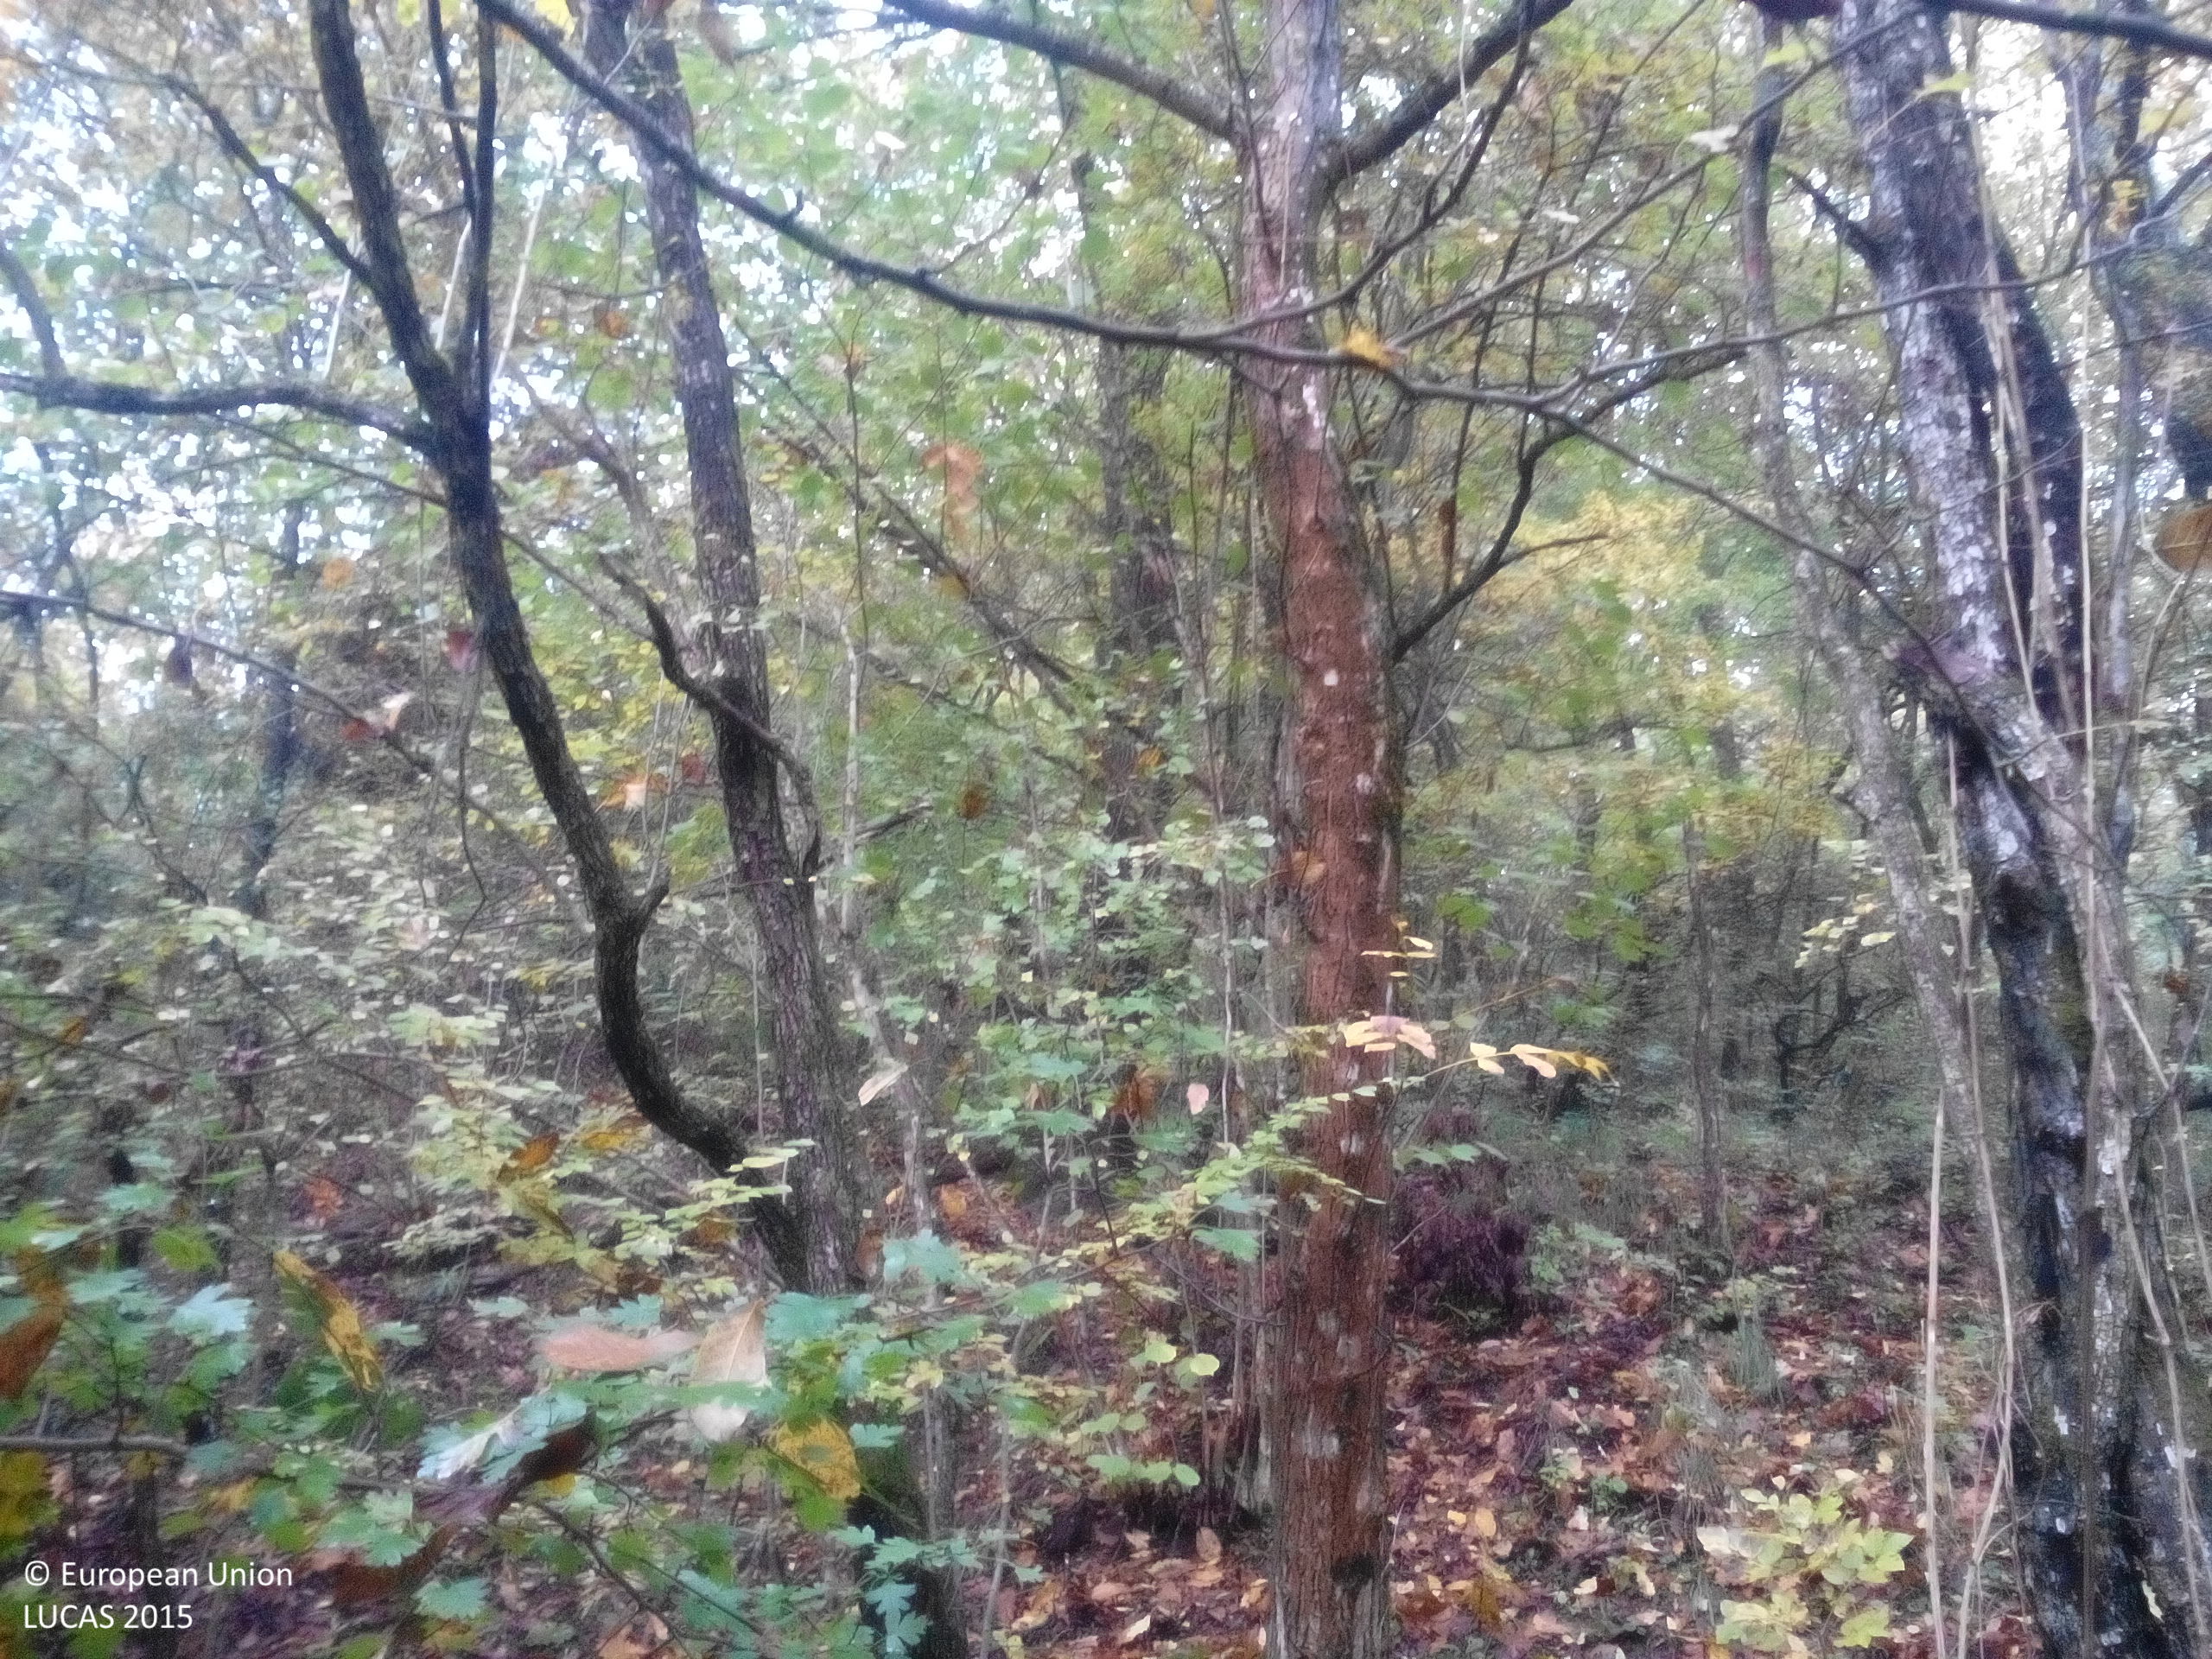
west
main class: Woodland
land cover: Broadleaved woodland
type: beech forest
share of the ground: > 75 %
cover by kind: broadleaved forest trees 95 %, shrubs 5 %
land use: Forestry
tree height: > 5 m
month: October
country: BG
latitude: 43.0218
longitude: 24.4498
